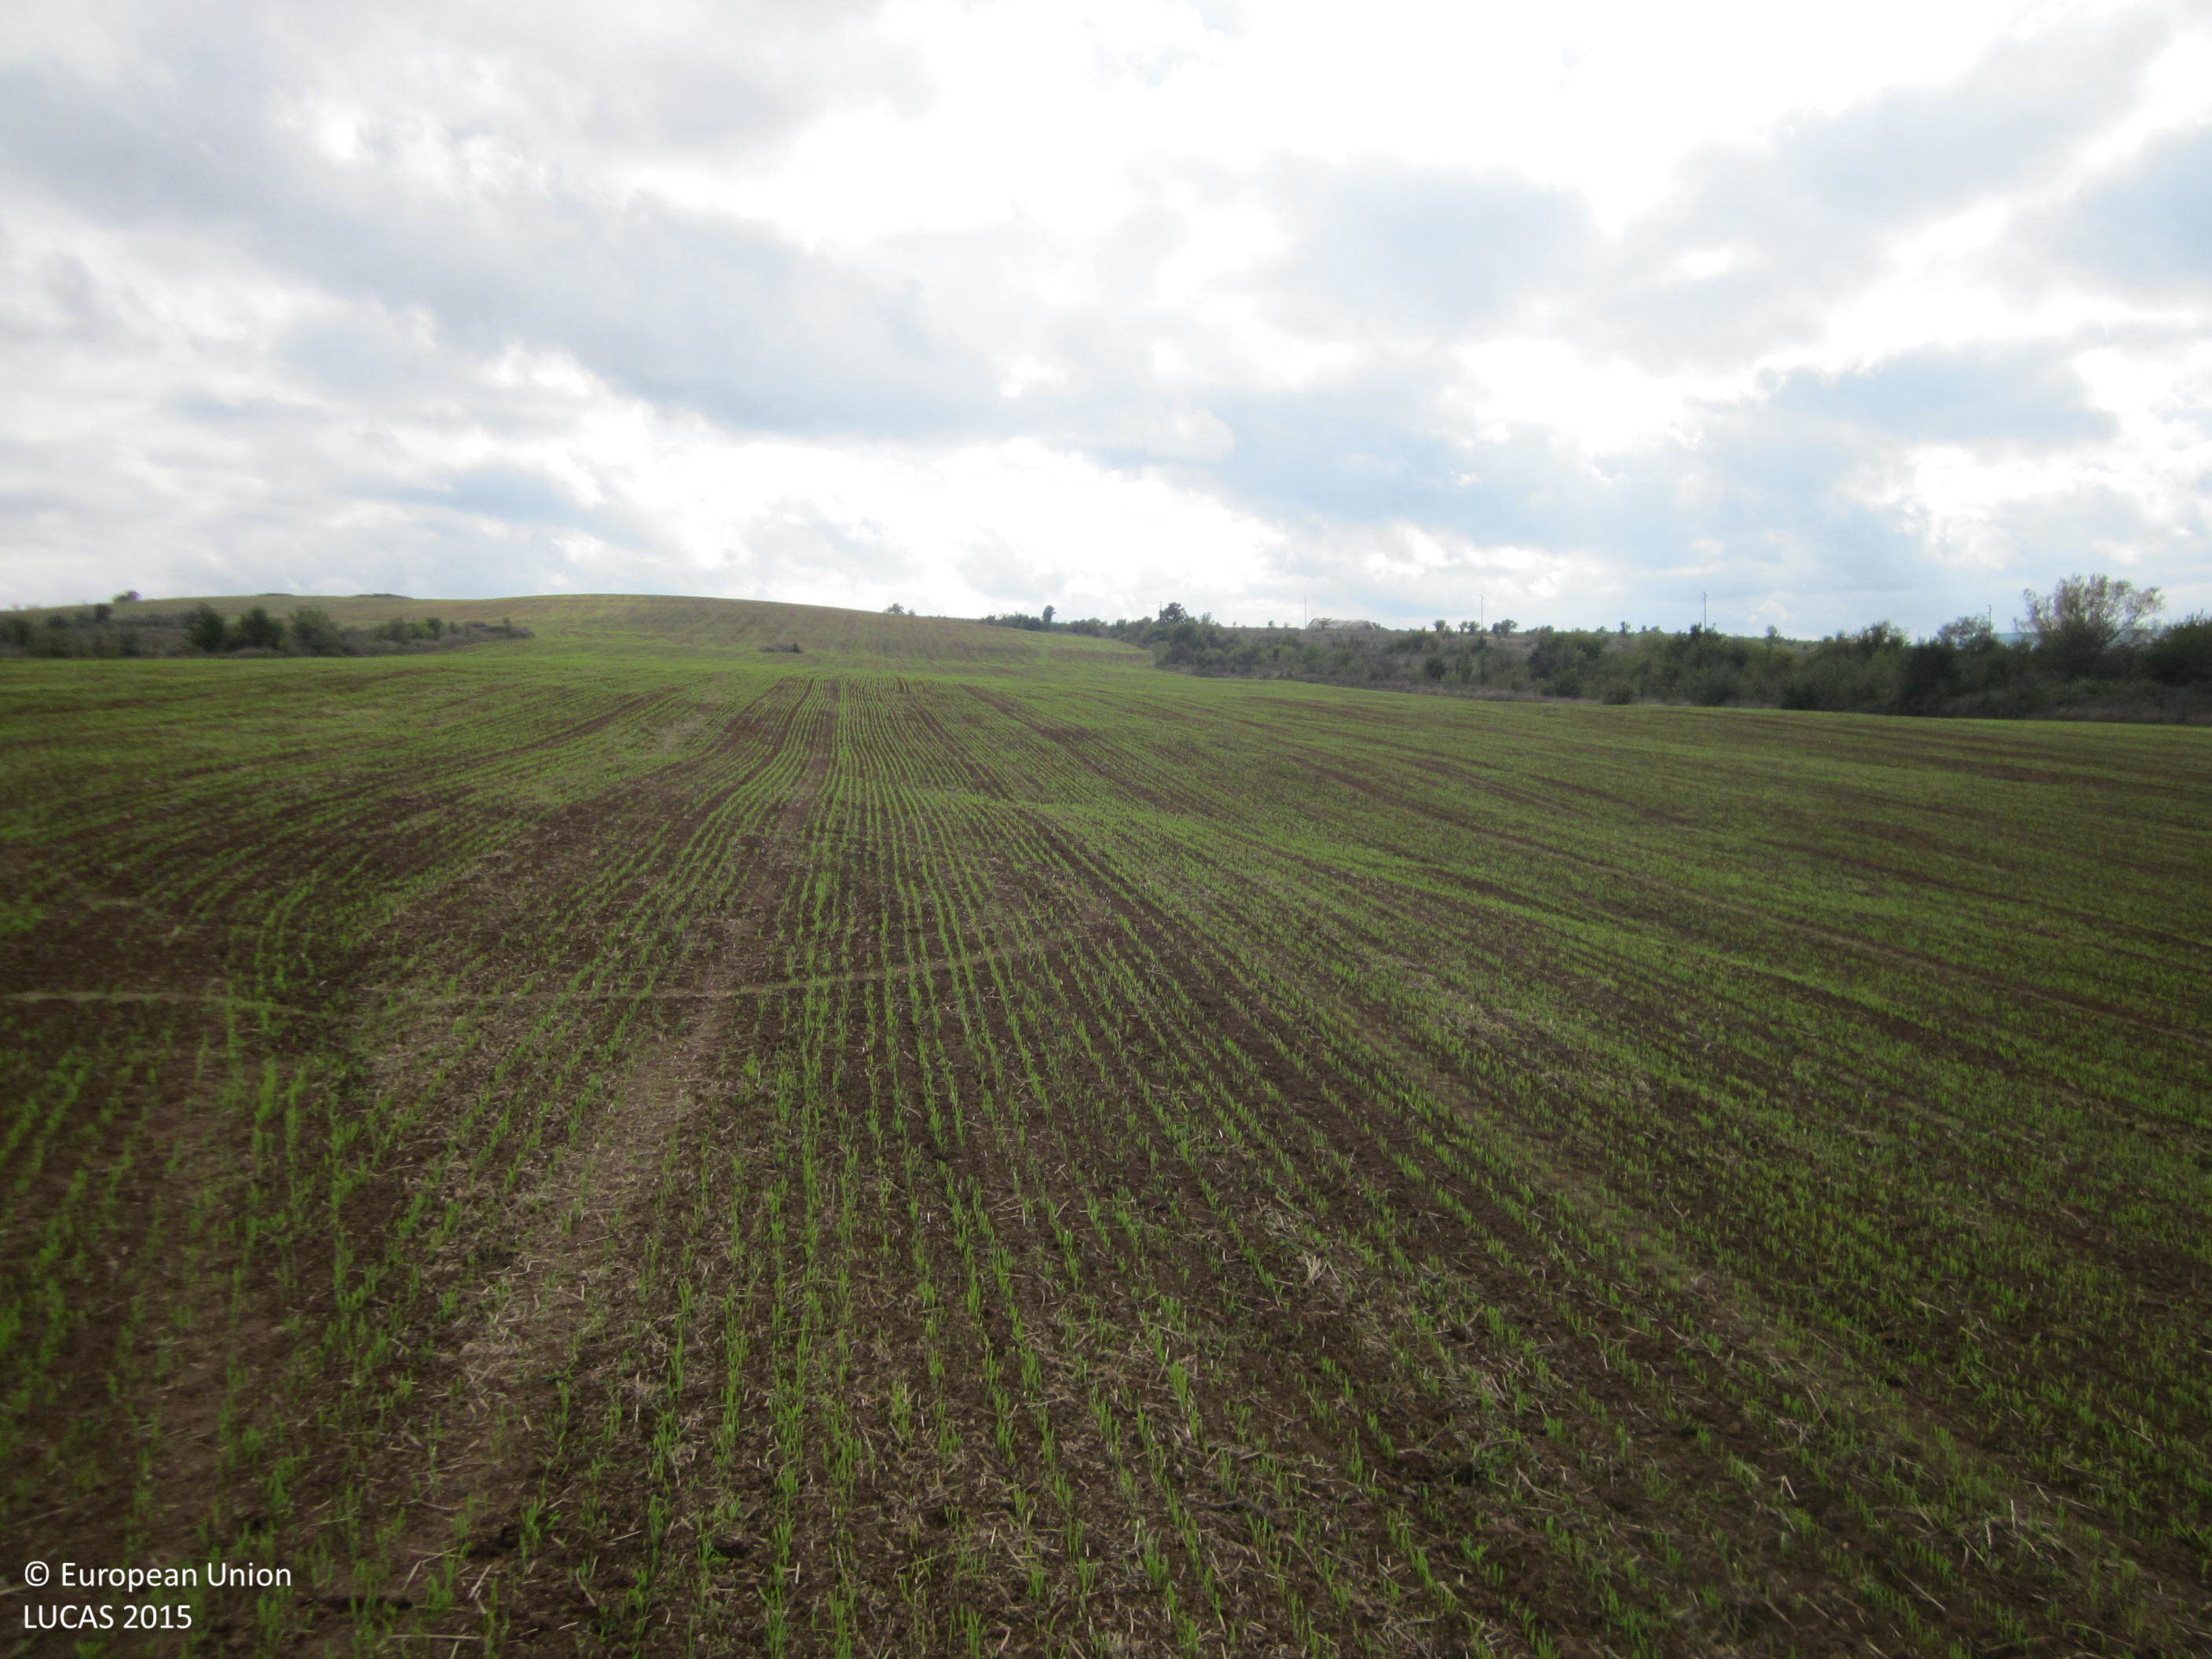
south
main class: Cropland
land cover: Common wheat
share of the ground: 10 - 25 %
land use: Agriculture (excluding fallow land and kitchen gardens)
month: October
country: BG
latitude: 42.2466
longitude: 27.2572
